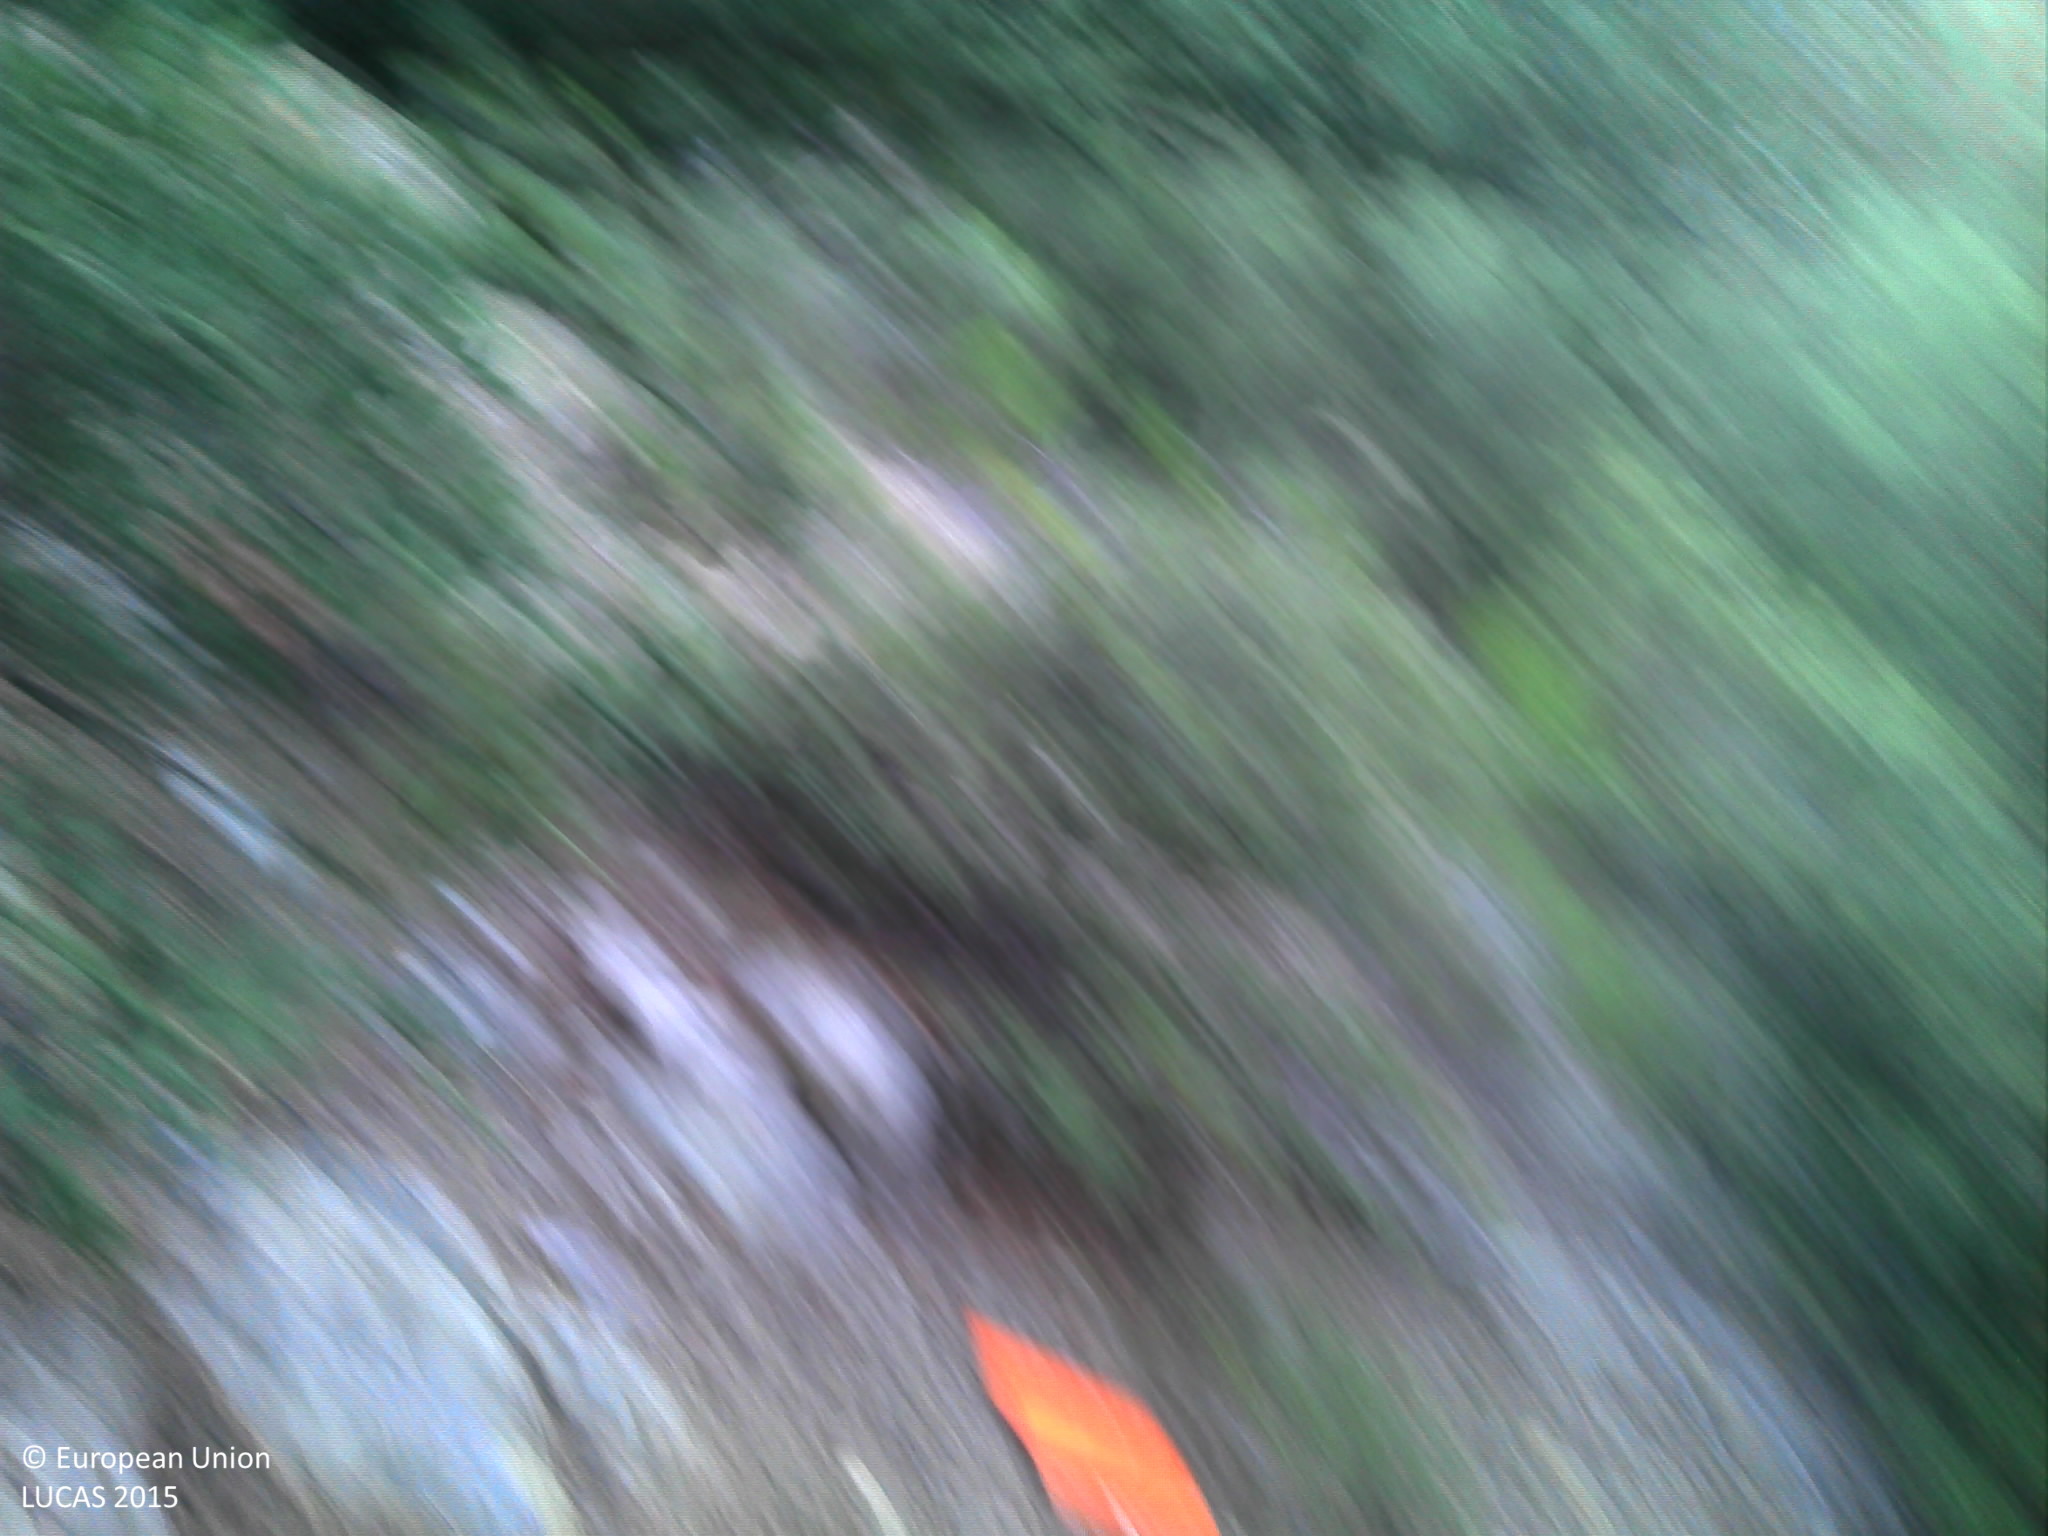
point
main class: Woodland
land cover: Pine dominated mixed woodland
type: thermophilous deciduous forest
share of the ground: > 75 %
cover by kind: coniferous forest trees 30 %, broadleaved forest trees 30 %, unconsolidated bare surface 20 %, shrubs 10 %, herbaceous plants 10 %
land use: Semi-natural and natural areas not in use
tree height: > 5 m
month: August
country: FR
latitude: 43.5523
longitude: 5.5905
